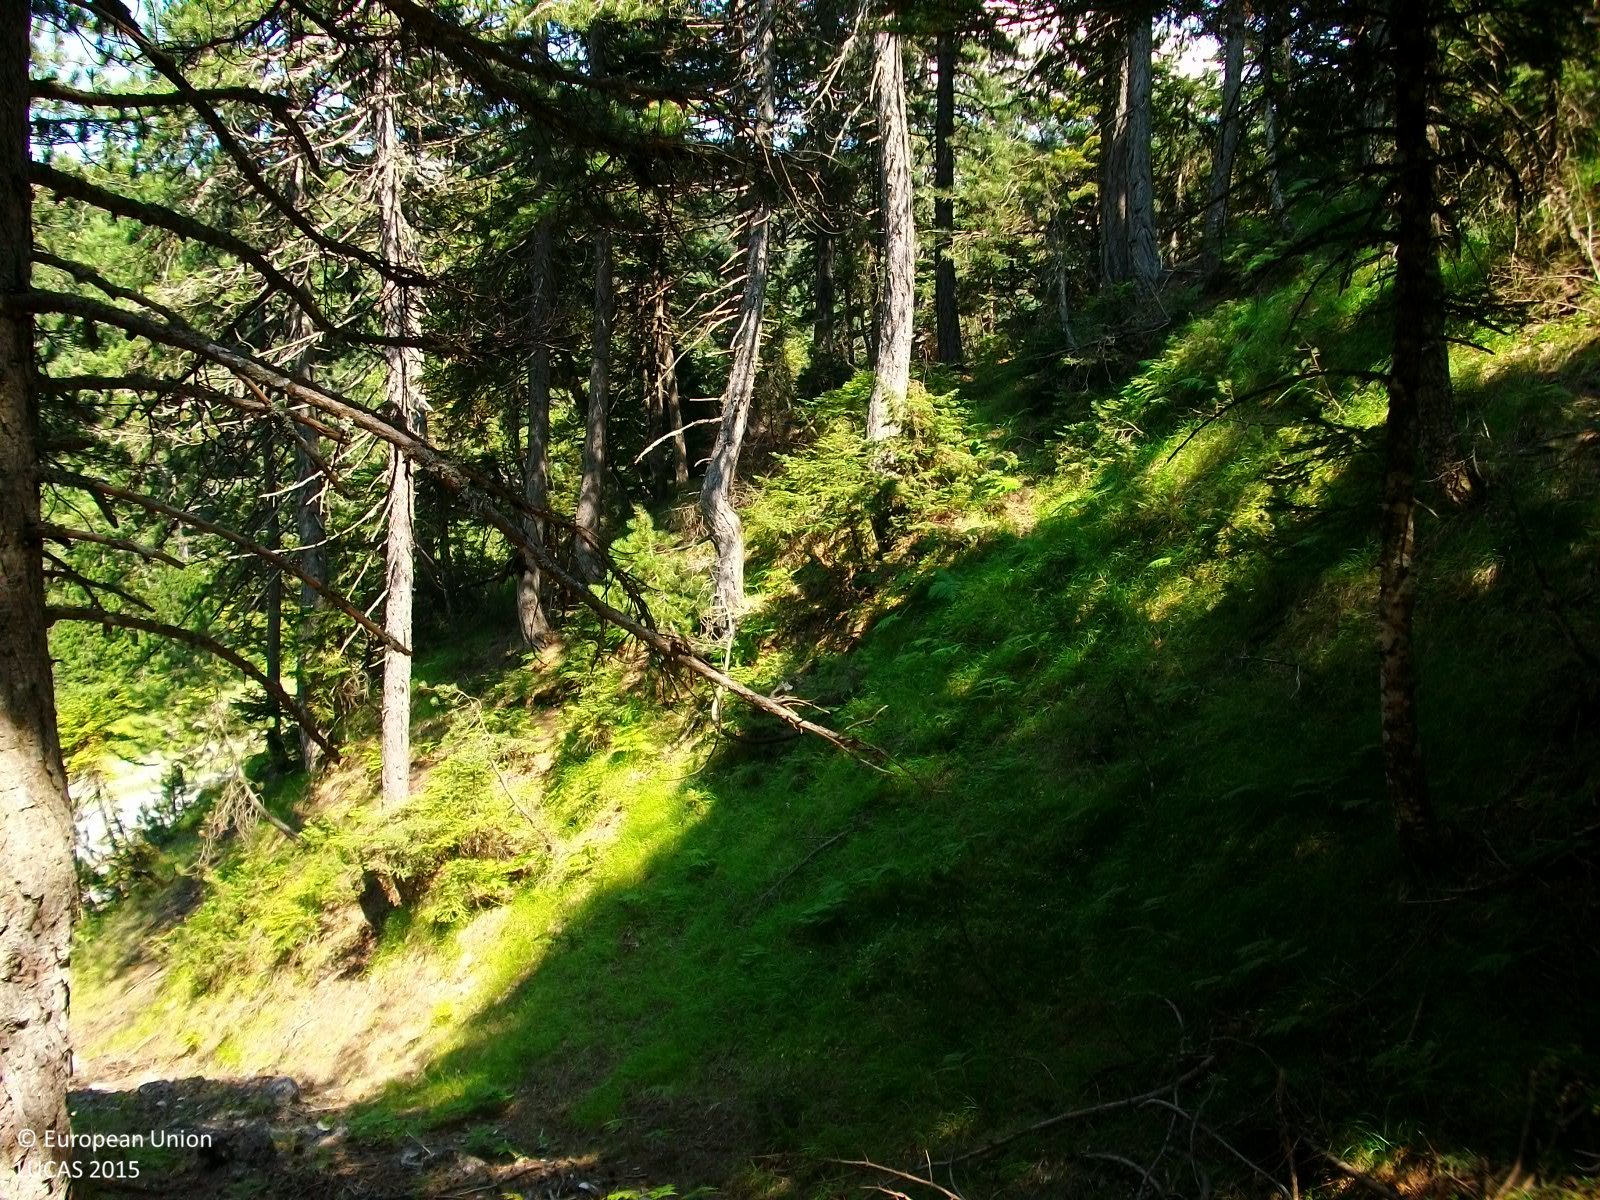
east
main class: Woodland
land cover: Spruce dominated mixed woodland
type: coniferous forest of the mediterranean region
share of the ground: > 75 %
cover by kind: coniferous forest trees 65 %, broadleaved forest trees 25 %, herbaceous plants 10 %
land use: Forestry
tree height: > 5 m
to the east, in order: Spruce dominated mixed woodland; Paved roads, cycling and walking lanes; Spruce dominated mixed woodland; Rock outcrops; Spruce dominated mixed woodland; Rivers and streams; Spruce dominated mixed woodland
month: July
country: GR
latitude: 38.5949
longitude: 22.5731
